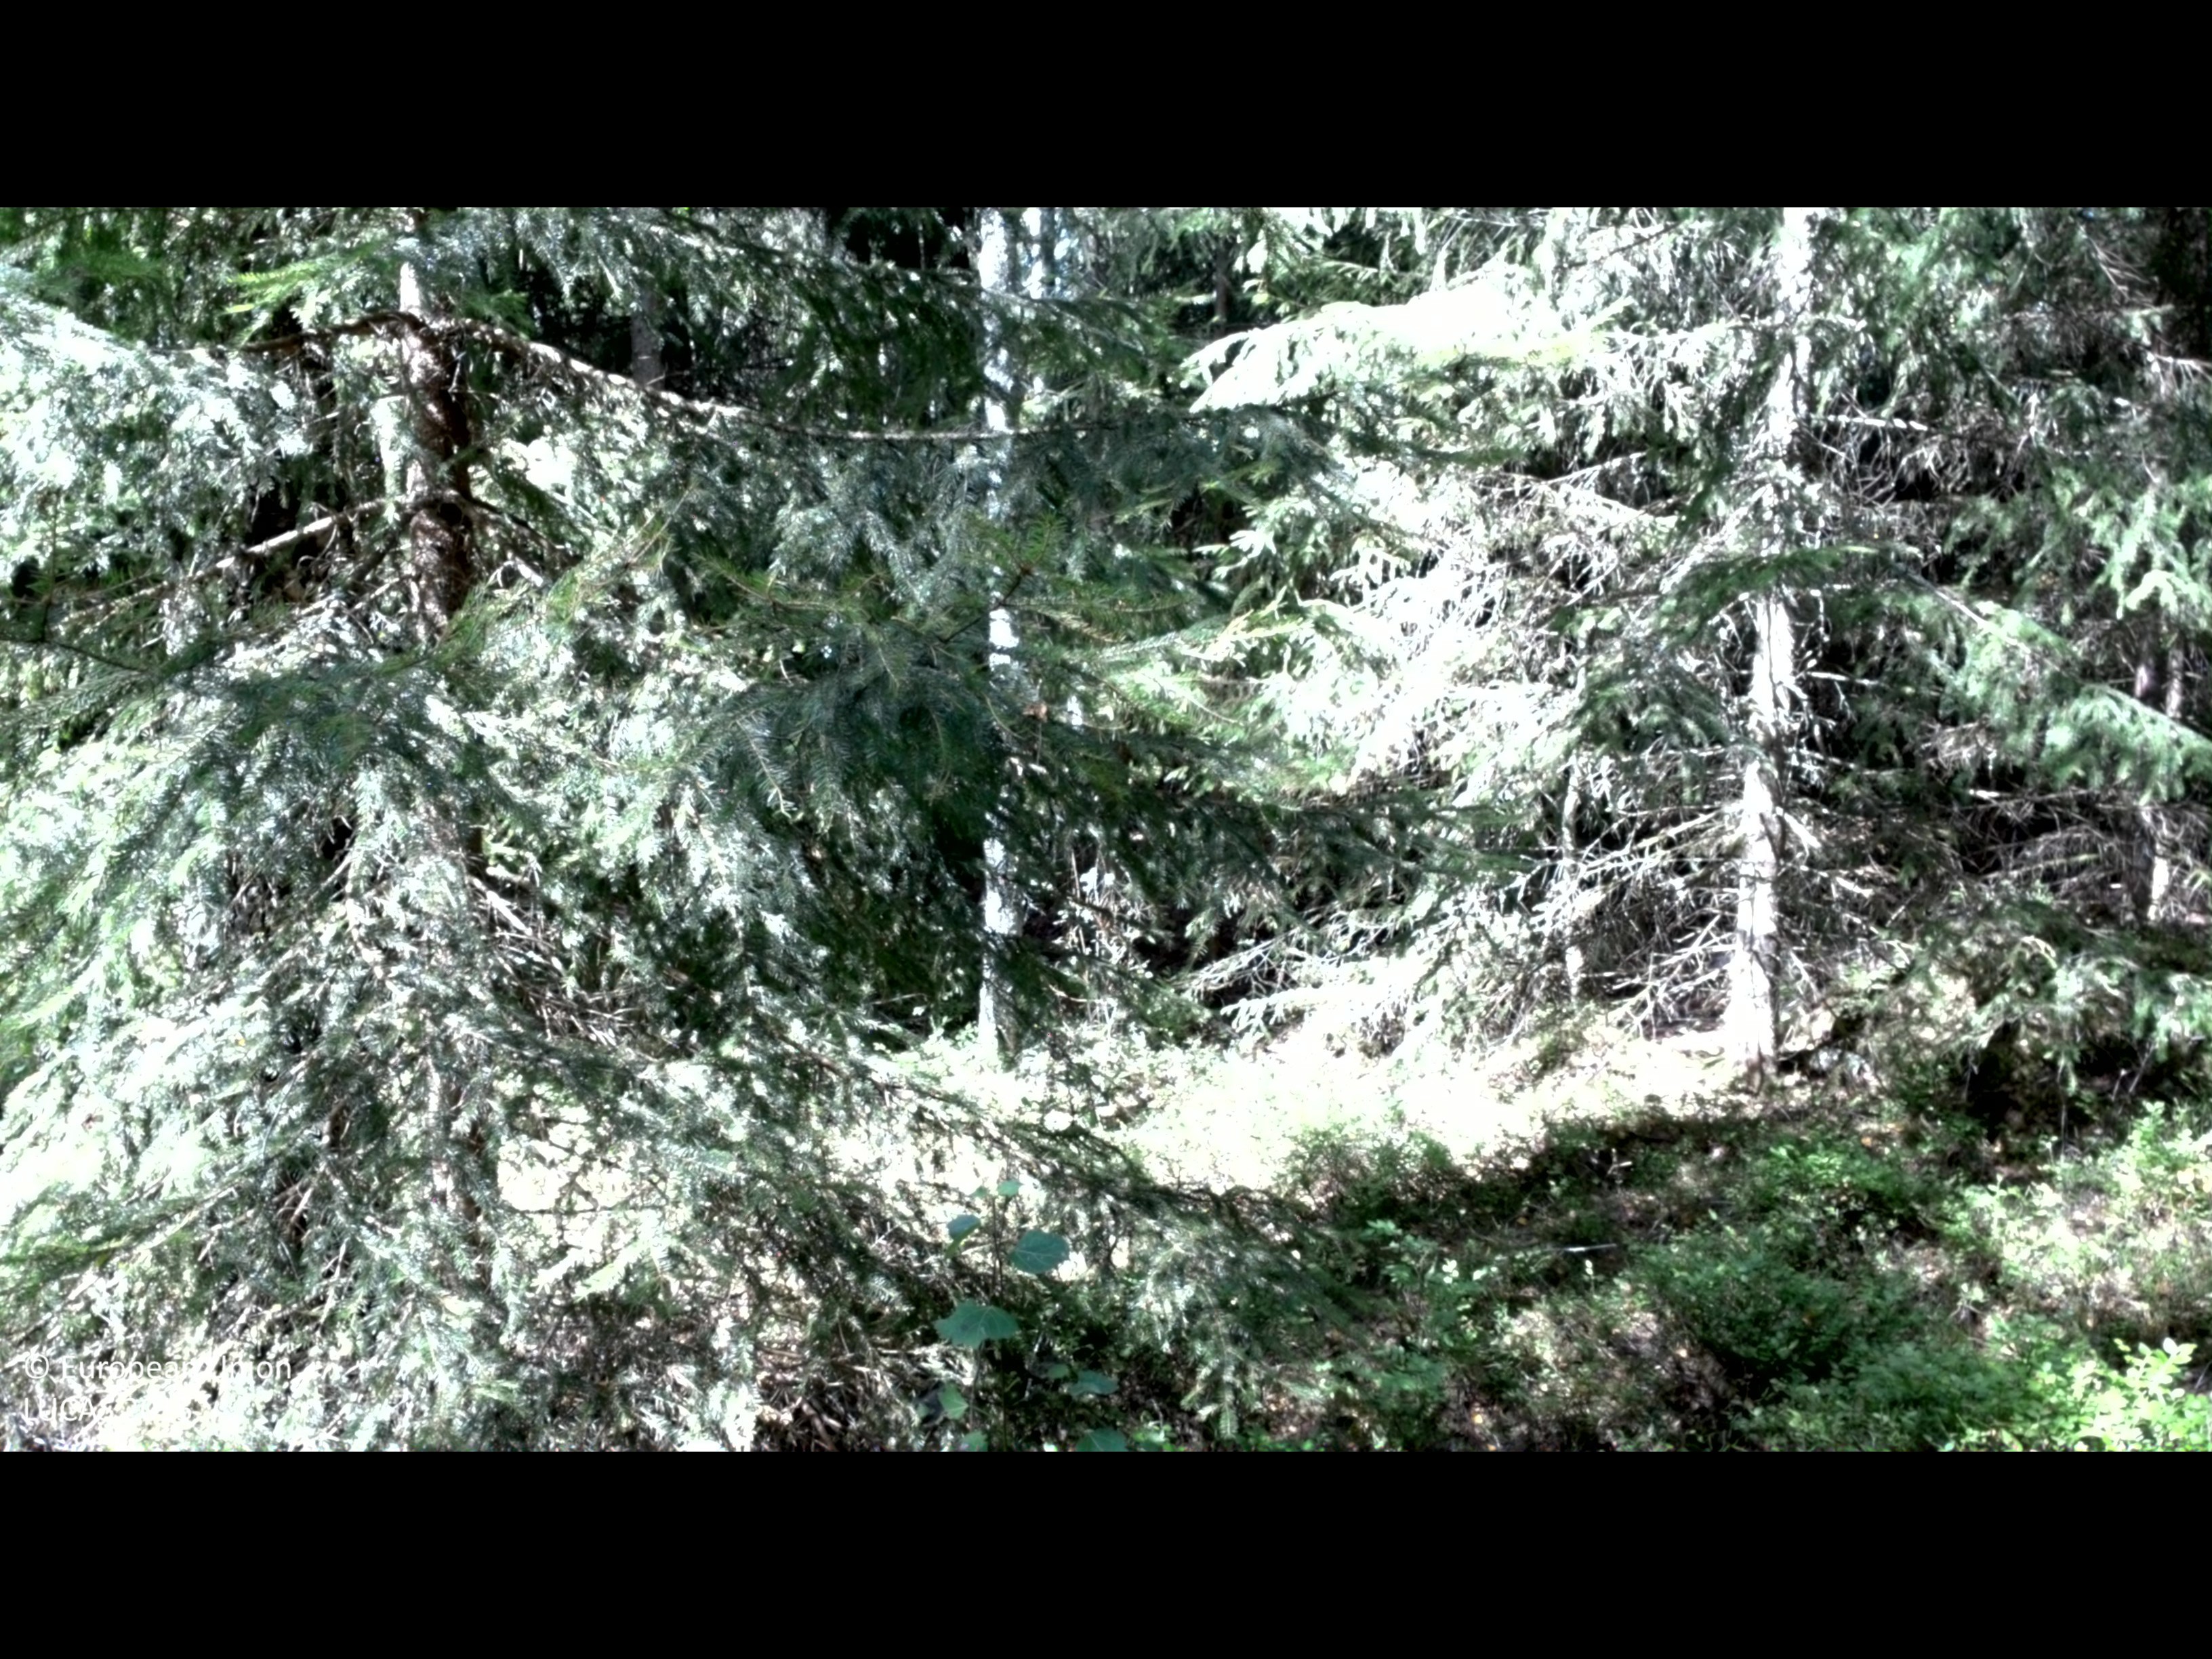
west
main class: Woodland
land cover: Spruce dominated mixed woodland
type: boreal forest
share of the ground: > 75 %
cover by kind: coniferous forest trees 50 %, broadleaved forest trees 30 %, shrubs 15 %, herbaceous plants 5 %
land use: Forestry
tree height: > 5 m
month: August
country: SE
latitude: 56.7450
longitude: 14.3299
